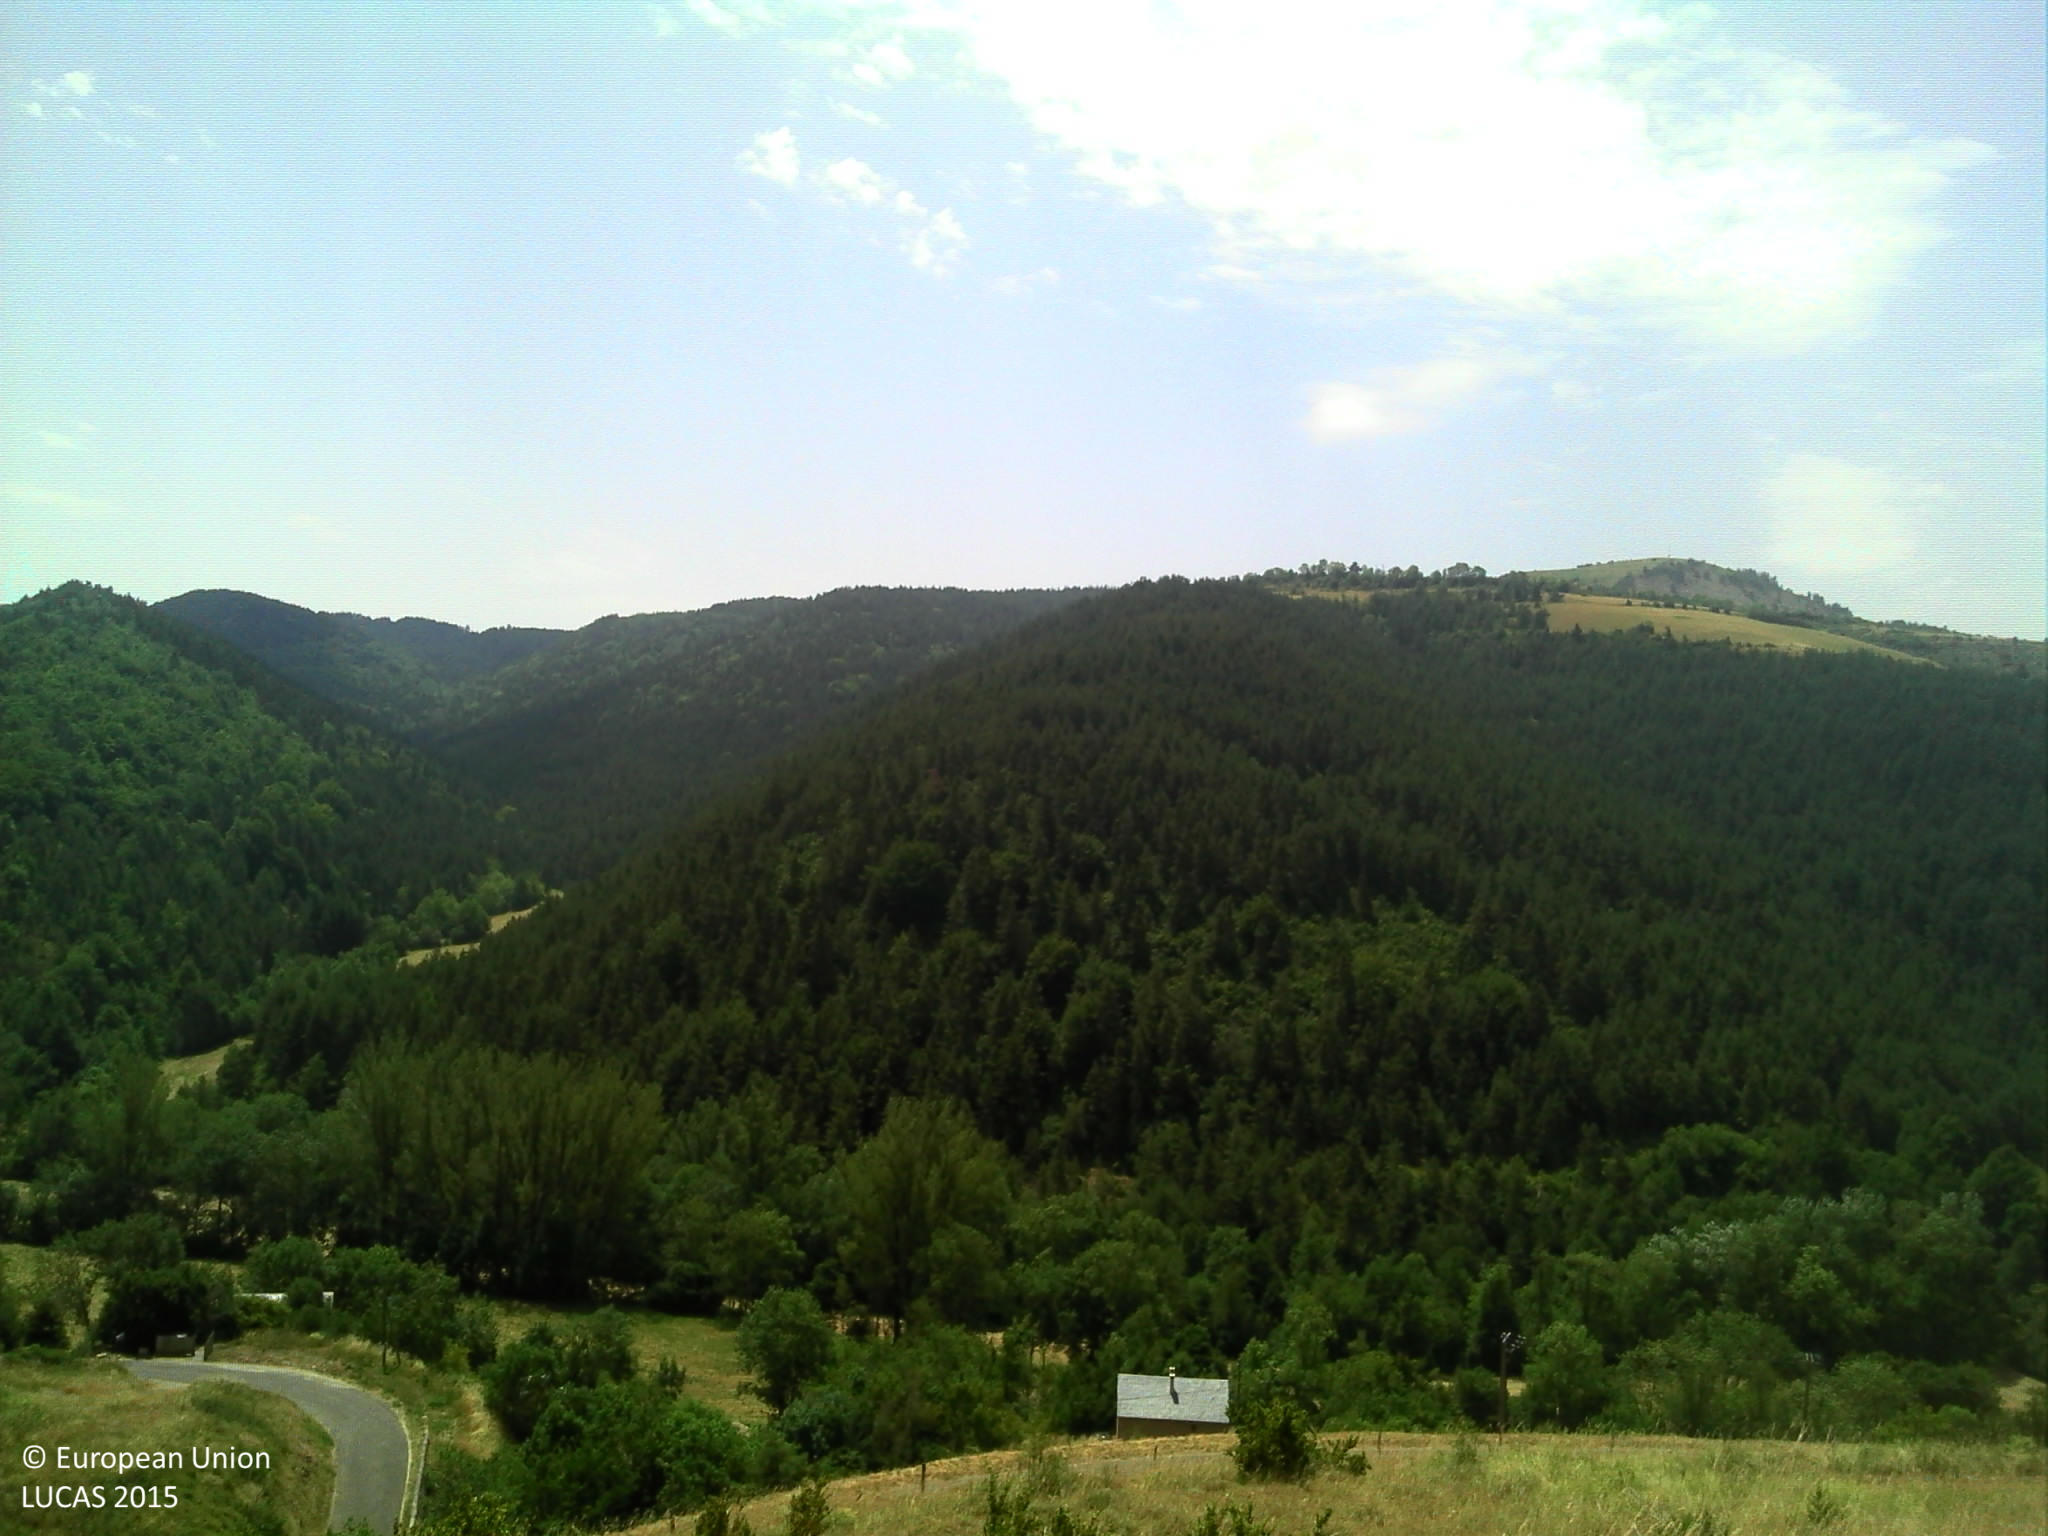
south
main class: Shrubland
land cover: Shrubland without tree cover
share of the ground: > 75 %
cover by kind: herbaceous plants 55 %, shrubs 45 %
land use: Agriculture (excluding fallow land and kitchen gardens)
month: July
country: FR
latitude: 44.2002
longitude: 3.4871
